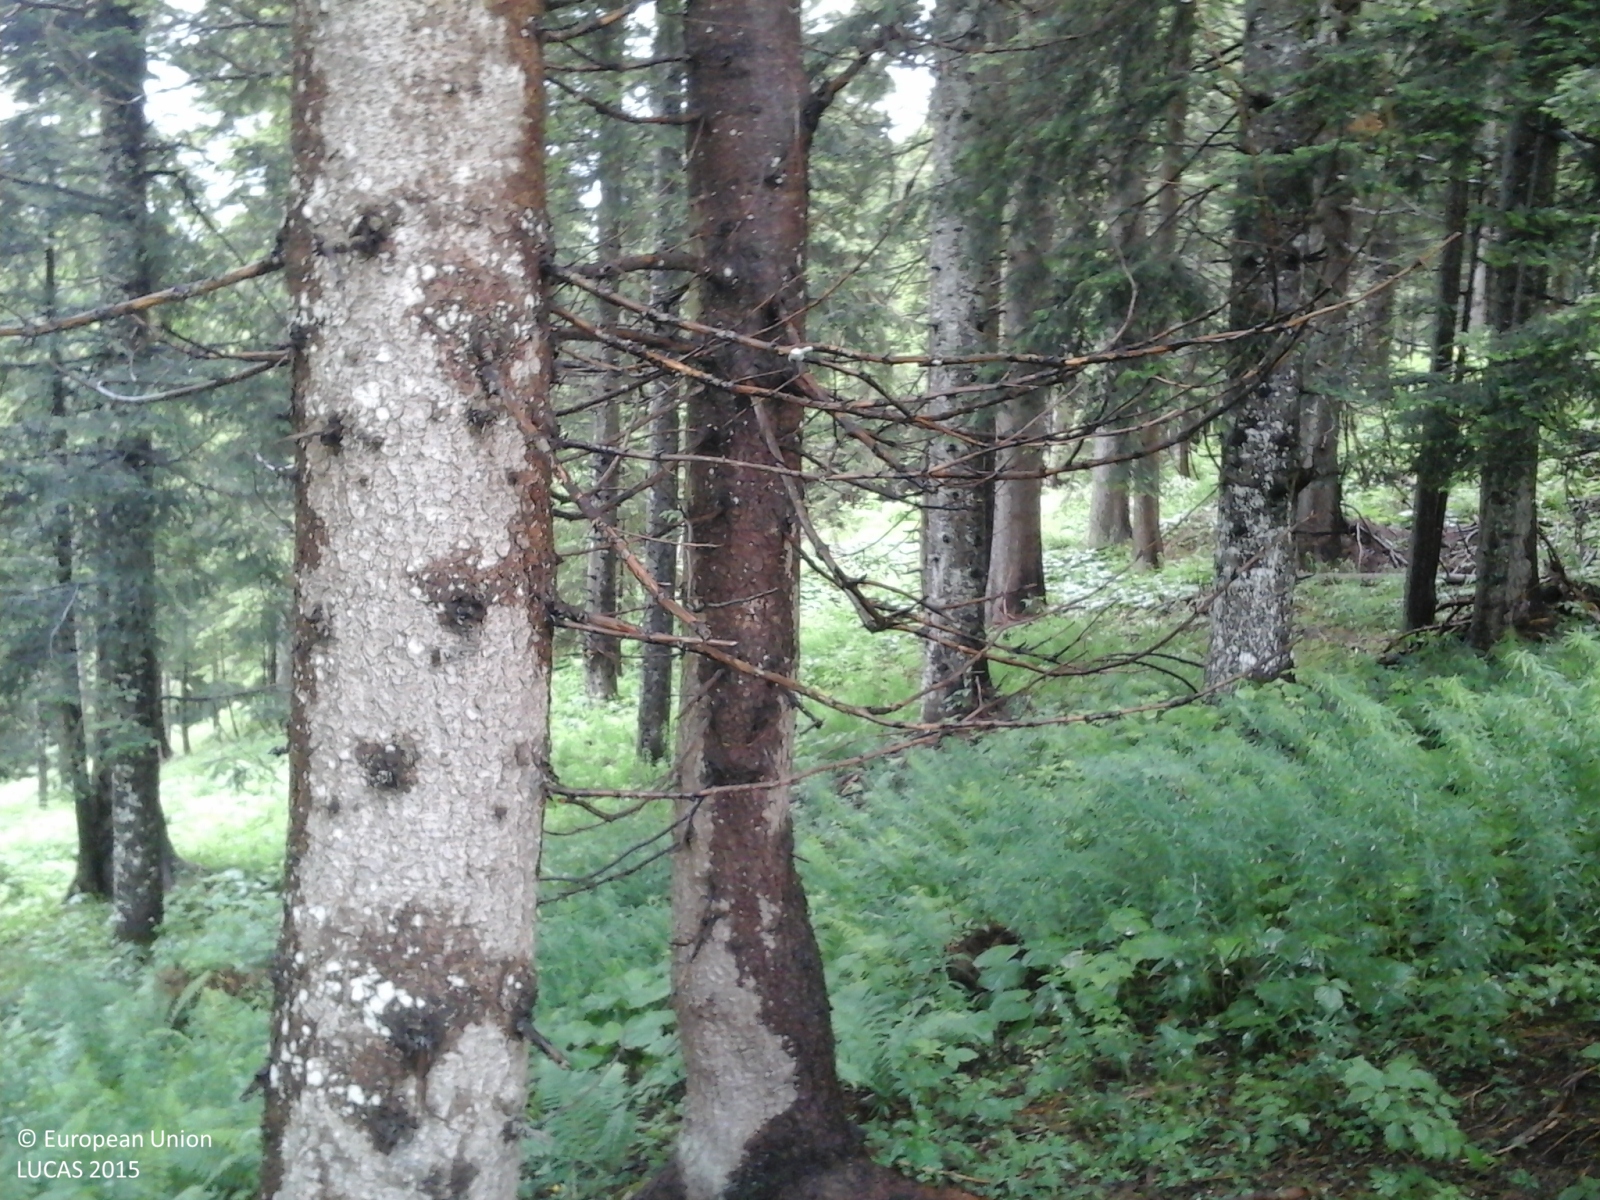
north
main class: Woodland
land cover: Spruce dominated coniferous woodland
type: alpine coniferous forest
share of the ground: > 75 %
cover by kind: coniferous forest trees 100 %
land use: Forestry
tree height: > 5 m
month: June
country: IT
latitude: 45.9787
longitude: 11.6112
